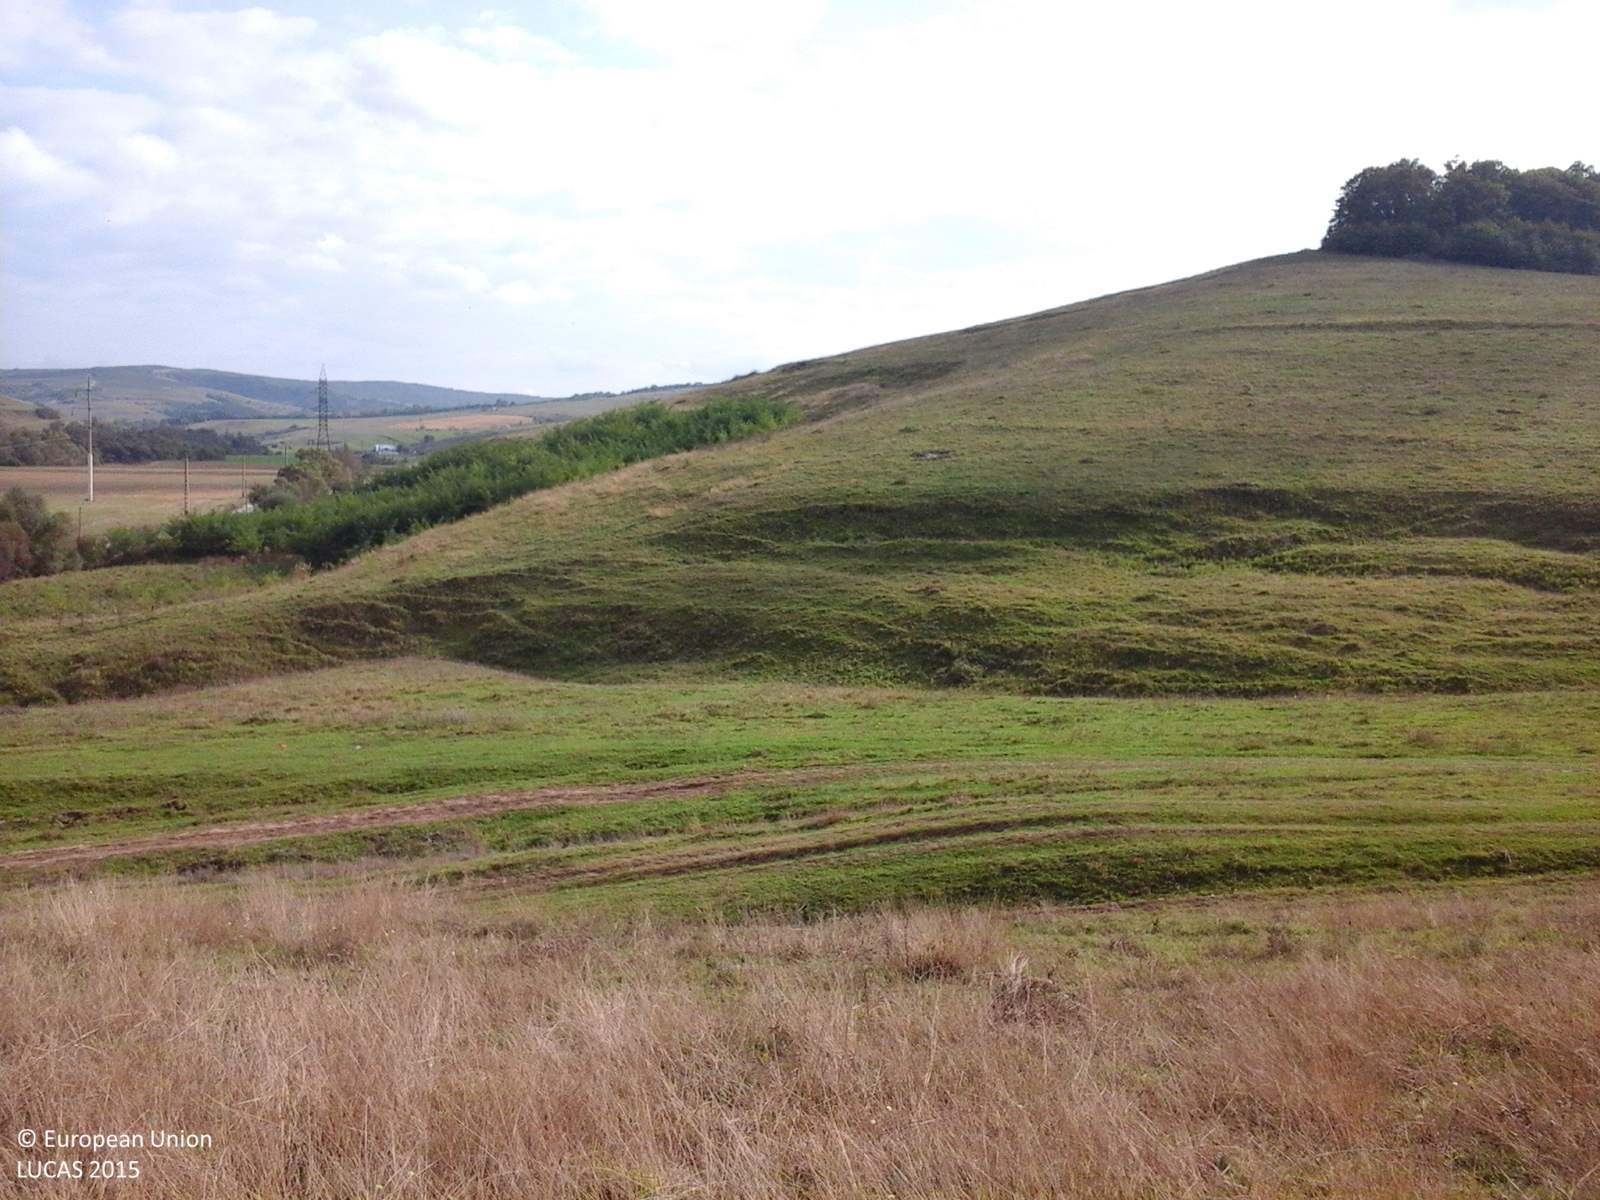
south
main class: Grassland
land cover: Grassland without tree/shrub cover
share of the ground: > 75 %
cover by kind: herbaceous plants 100 %
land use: Agriculture (excluding fallow land and kitchen gardens)
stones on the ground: < 10 %
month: October
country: RO
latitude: 46.1890
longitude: 24.1617
